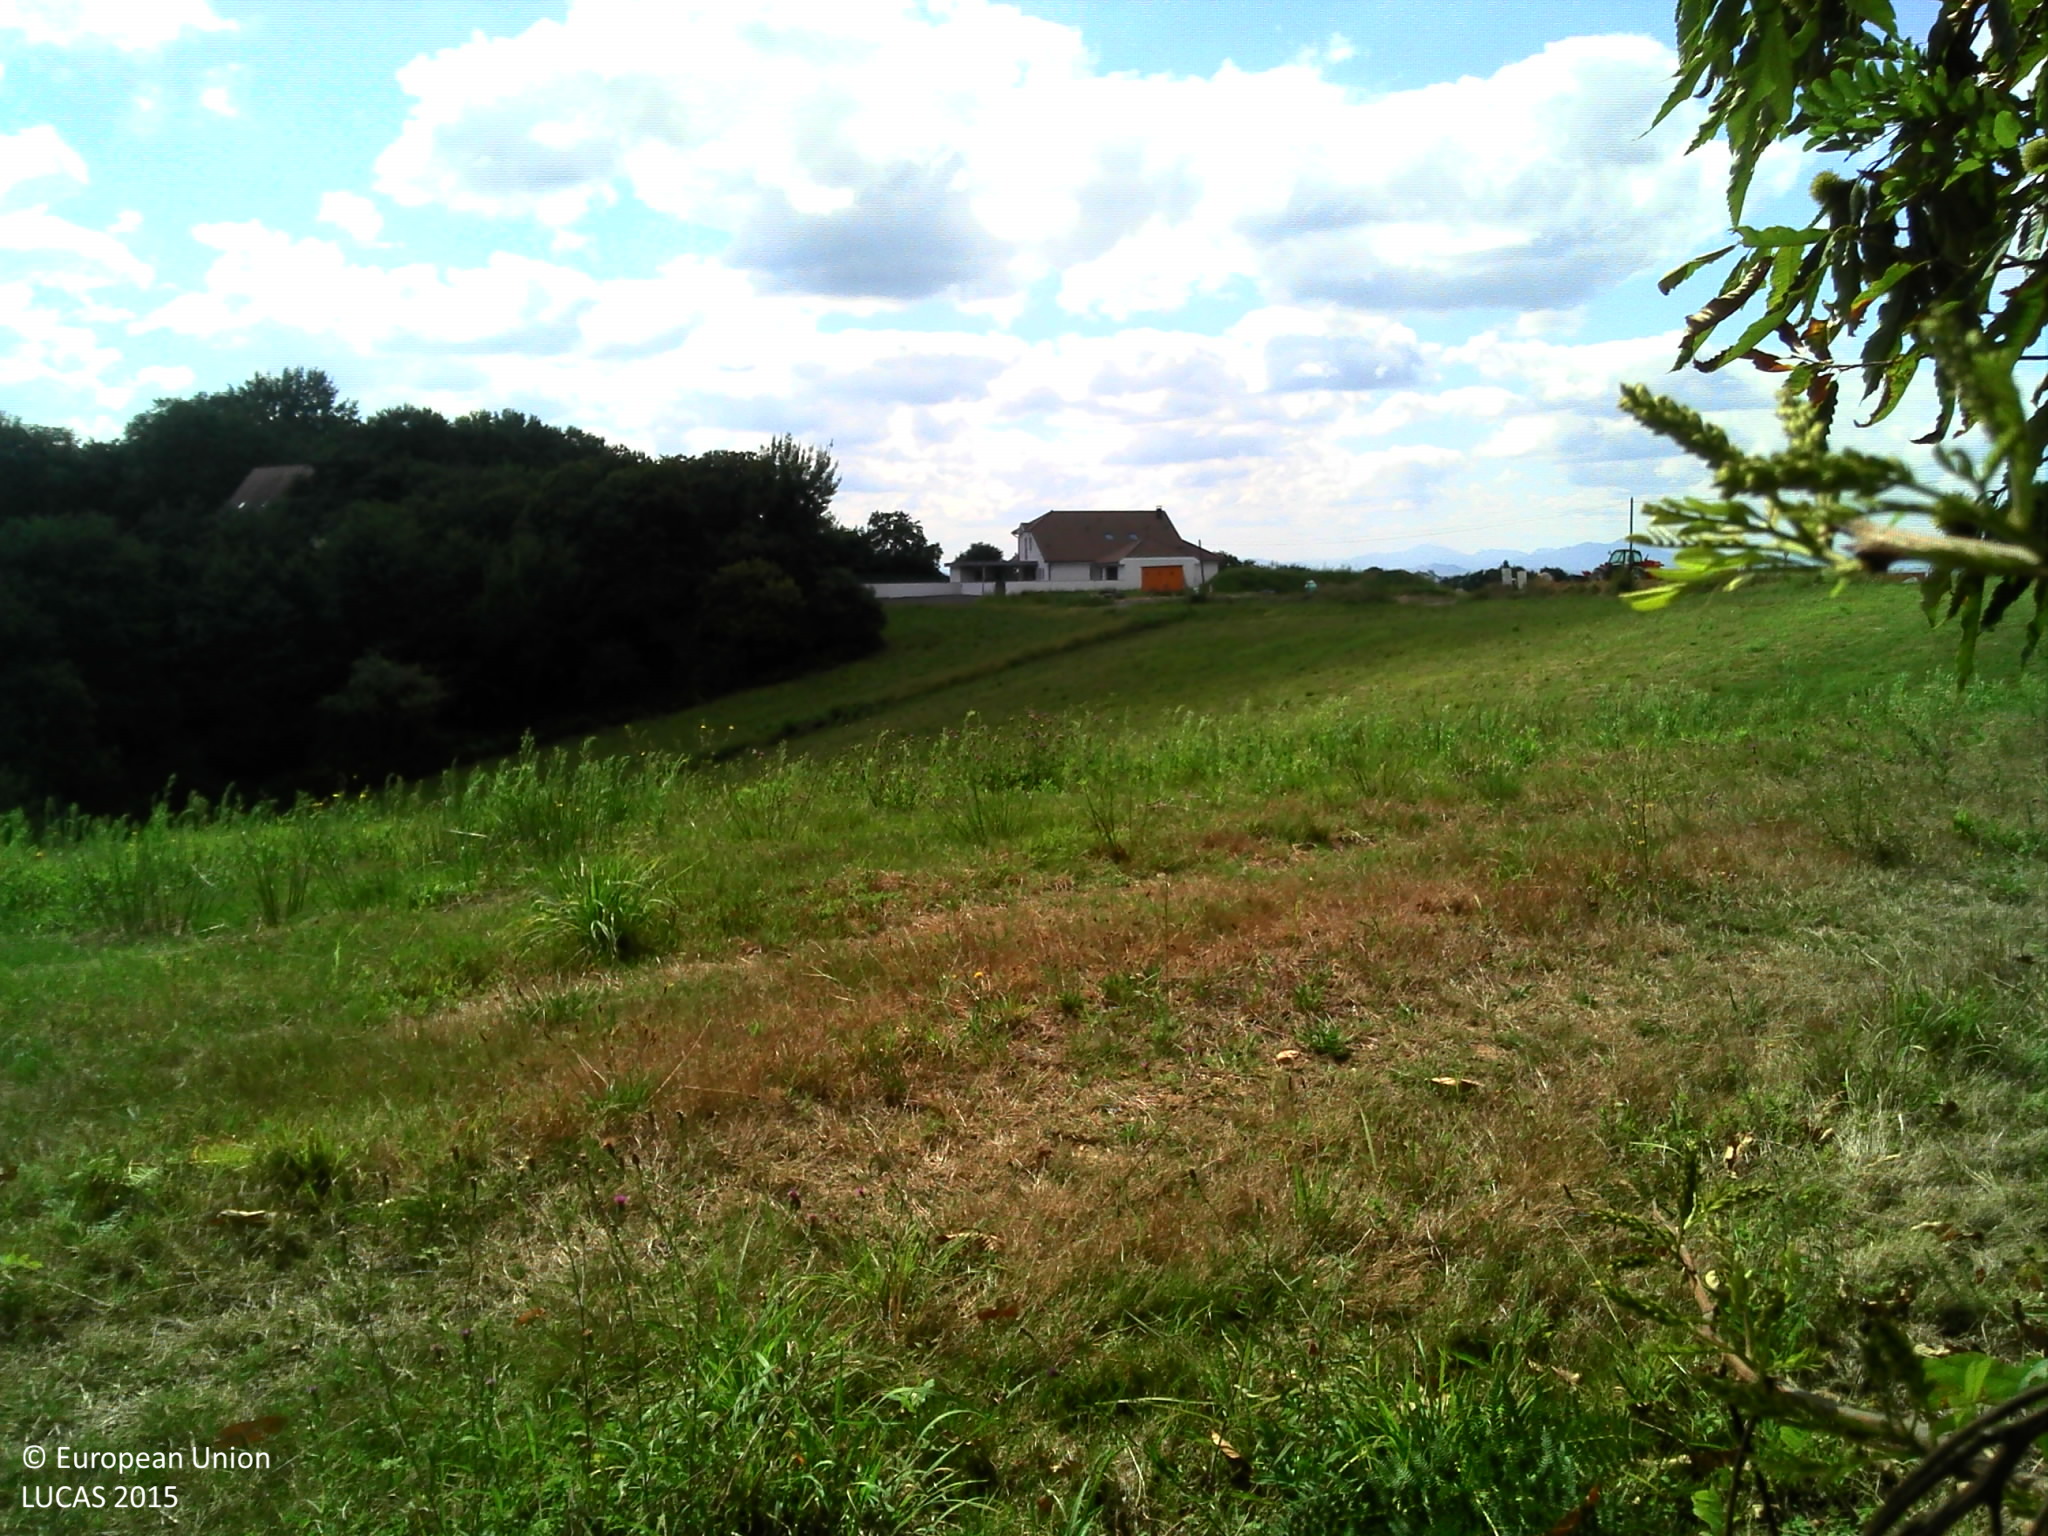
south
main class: Woodland
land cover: Broadleaved woodland
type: acidophilous oak and oak-birch forest
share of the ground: > 75 %
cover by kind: broadleaved forest trees 75 %, shrubs 10 %, herbaceous plants 10 %, lichens and mosses 5 %
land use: Forestry
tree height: > 5 m
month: September
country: FR
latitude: 43.4956
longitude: -0.9577
